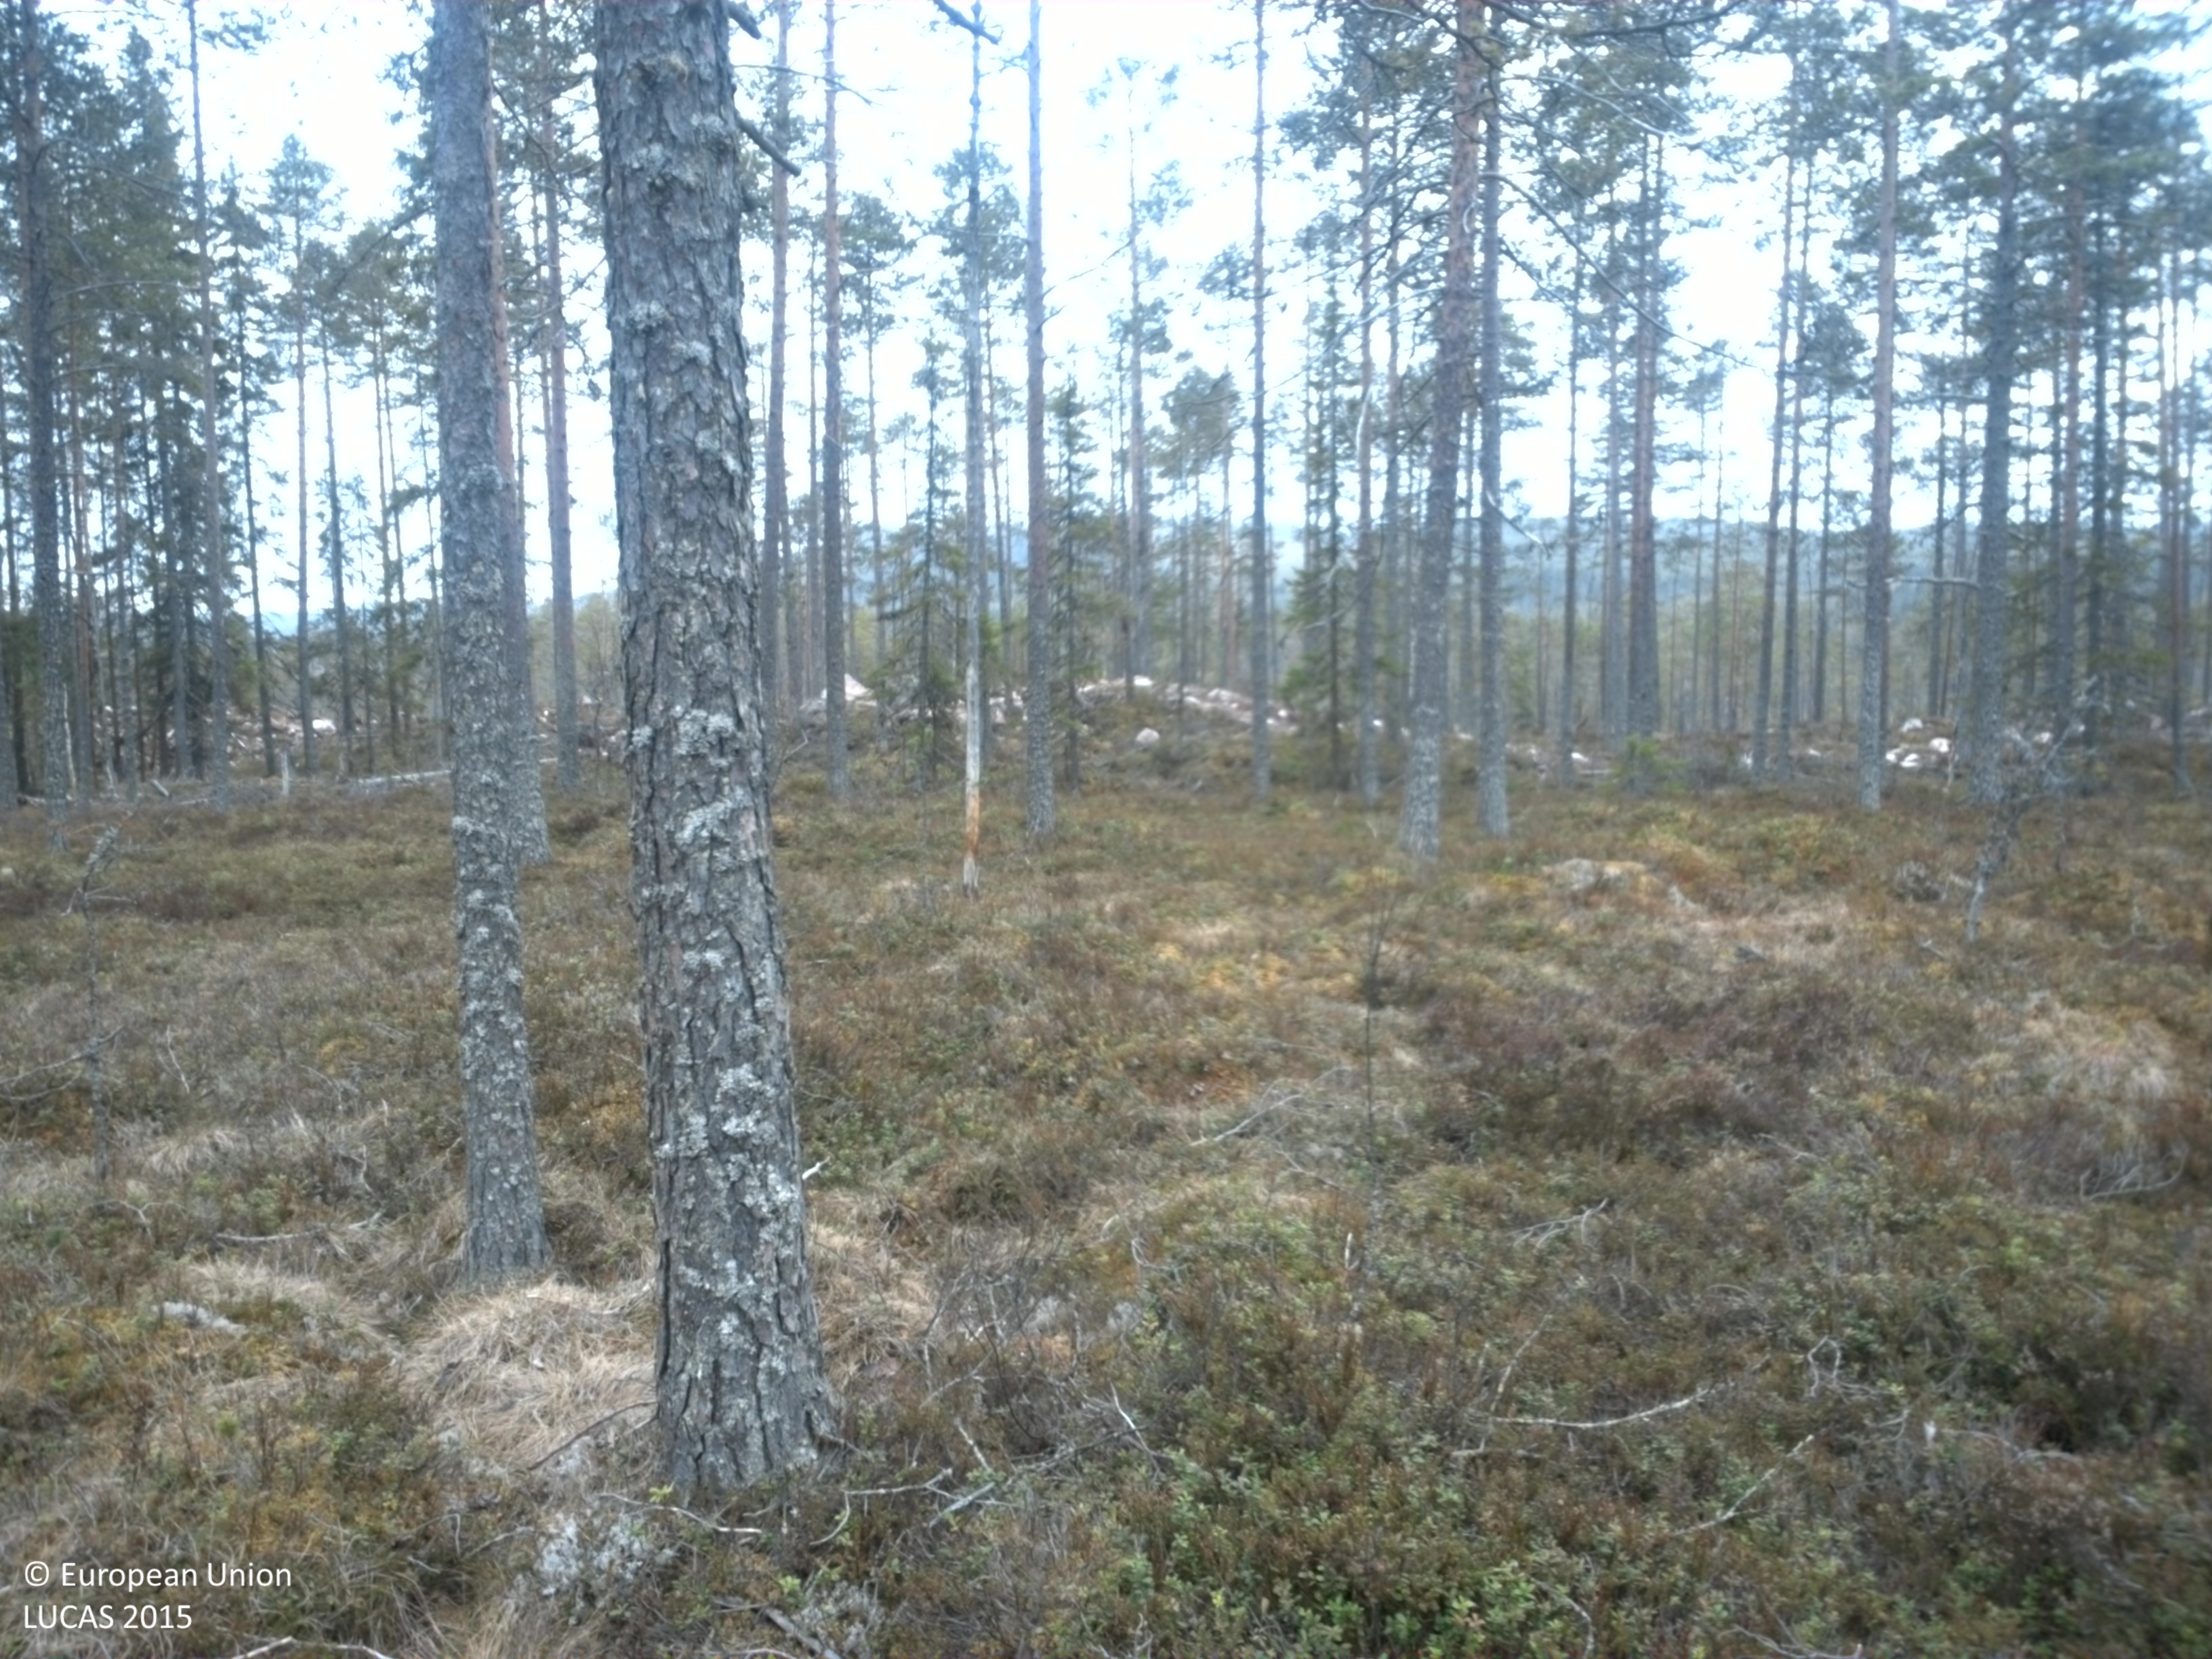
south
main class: Woodland
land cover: Pine dominated coniferous woodland
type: boreal forest
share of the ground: 25 - 50 %
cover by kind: coniferous forest trees 45 %, shrubs 25 %, lichens and mosses 25 %, herbaceous plants 5 %
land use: Forestry
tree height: > 5 m
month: May
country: SE
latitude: 60.9163
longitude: 13.3272
